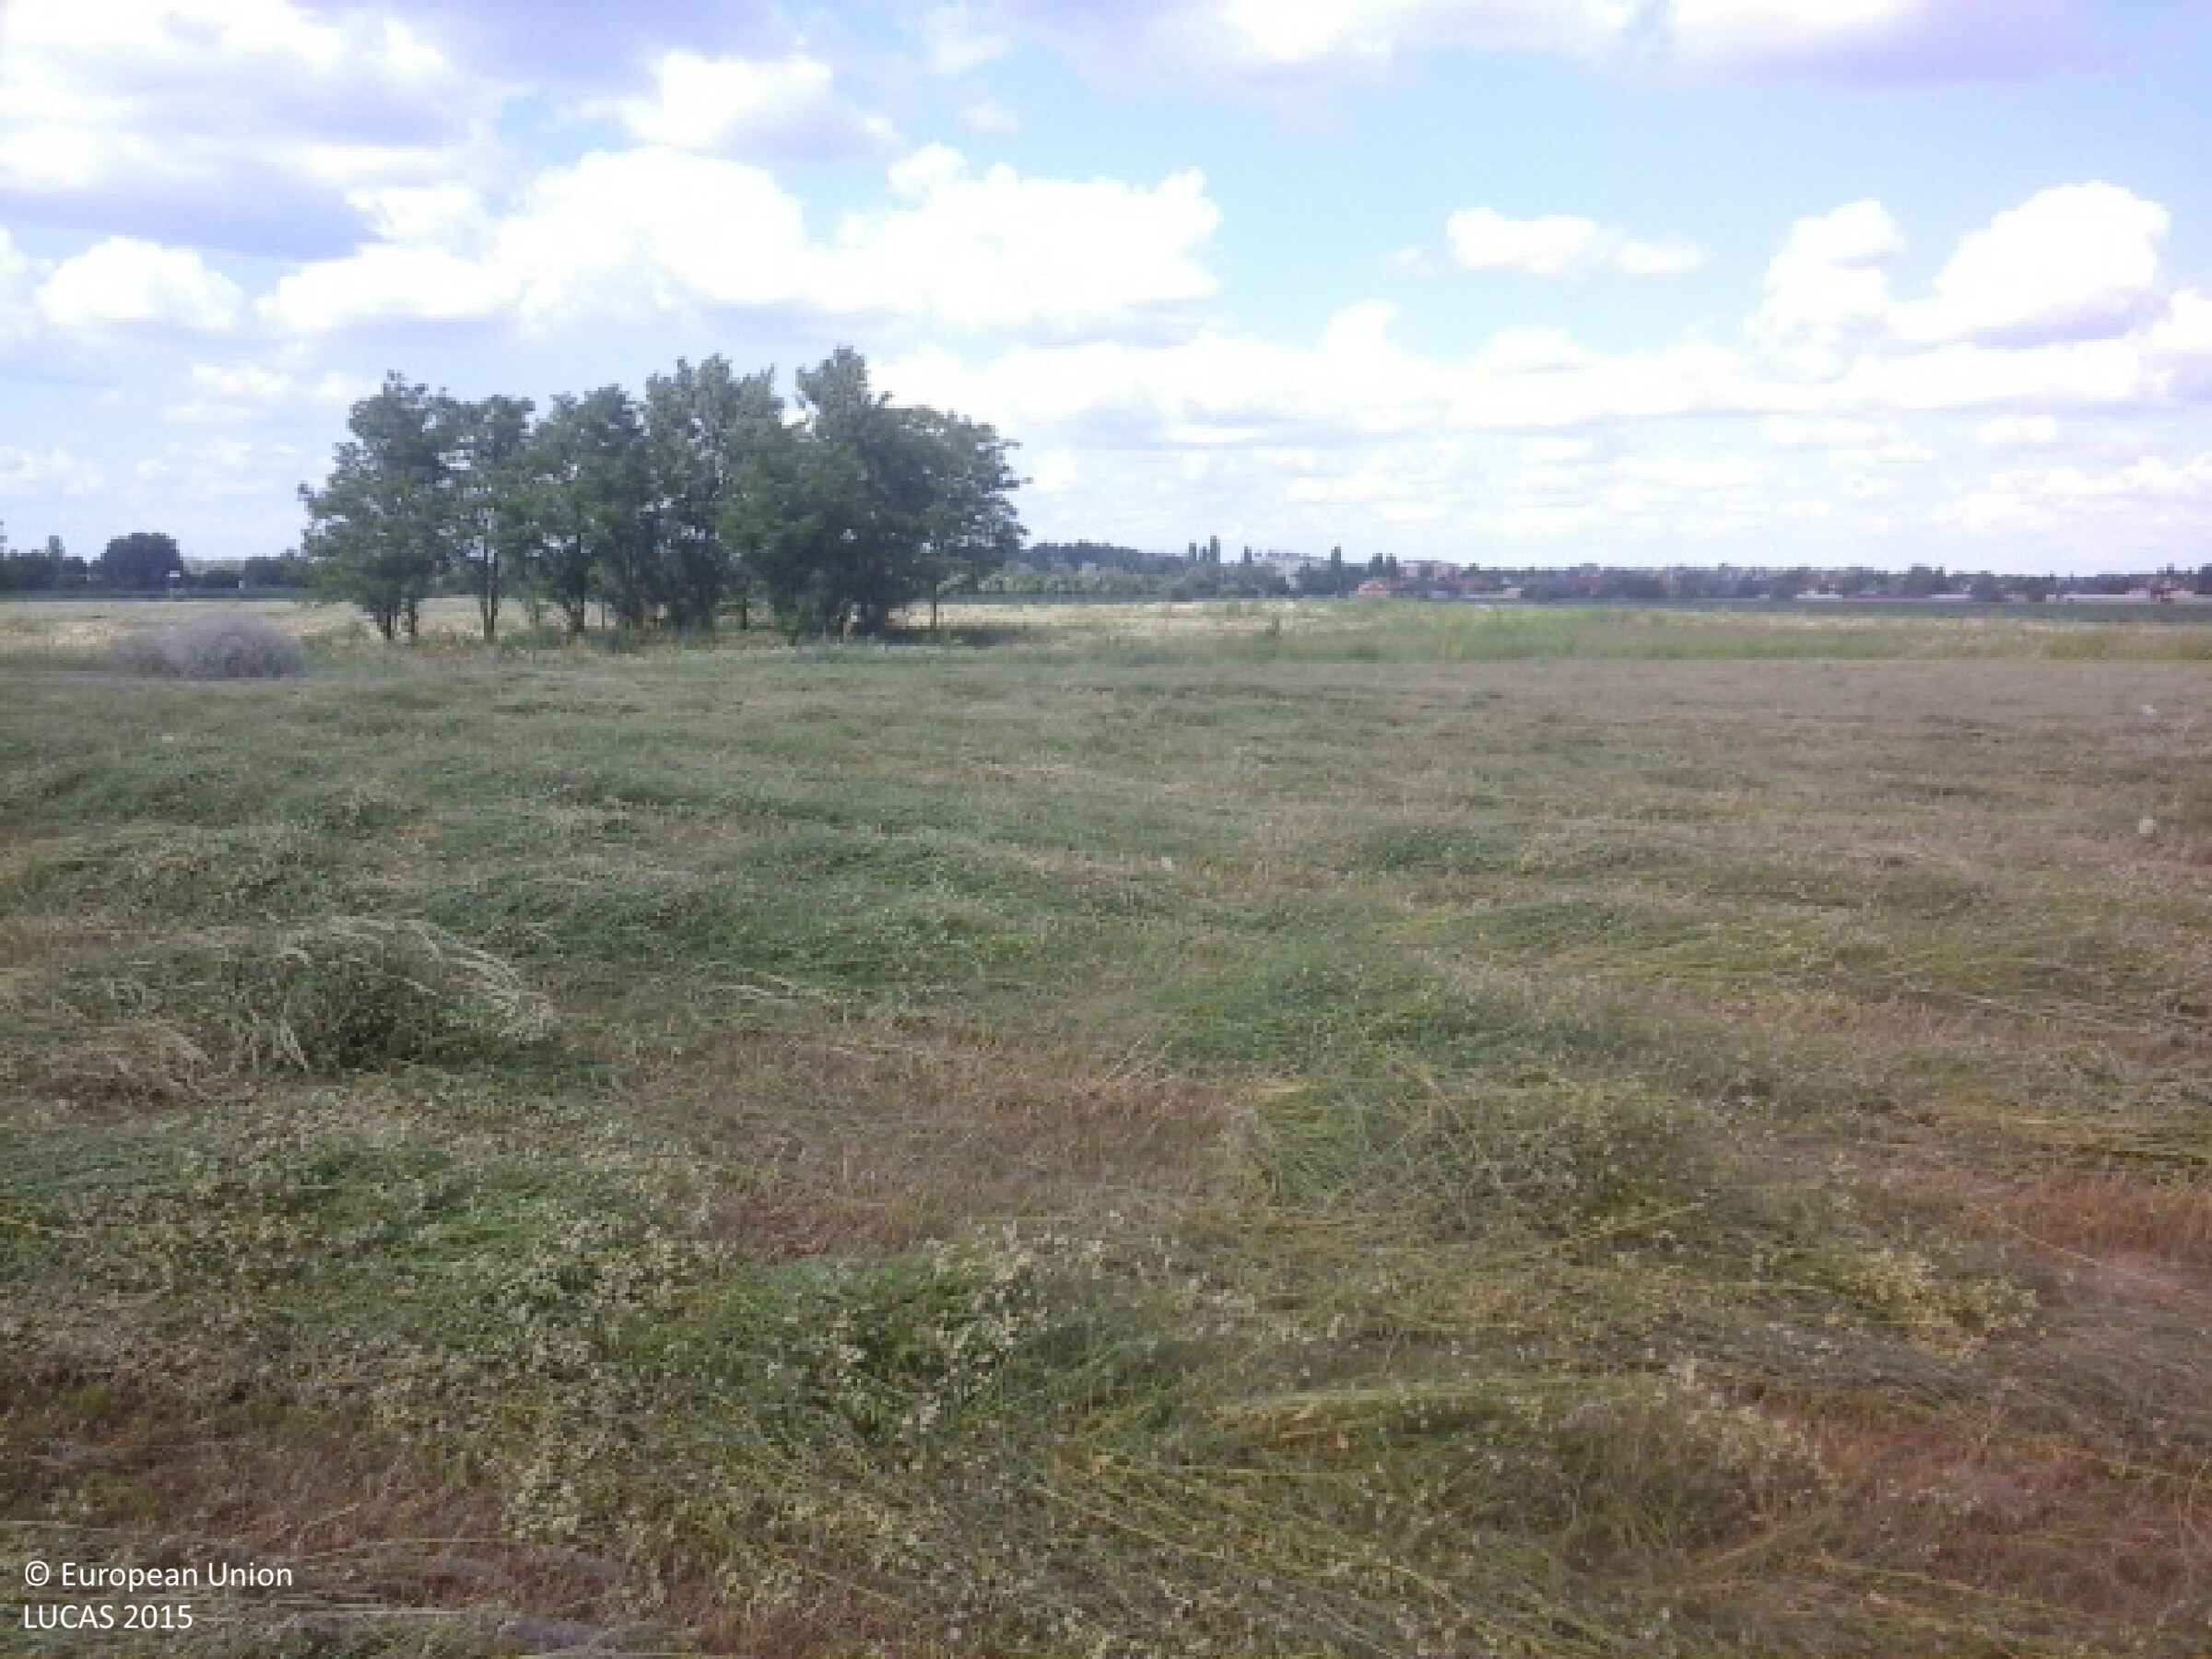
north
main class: Grassland
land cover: Grassland without tree/shrub cover
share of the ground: > 75 %
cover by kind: herbaceous plants 100 %
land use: Agriculture (excluding fallow land and kitchen gardens)
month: June
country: HU
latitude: 47.3966
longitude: 19.0668
